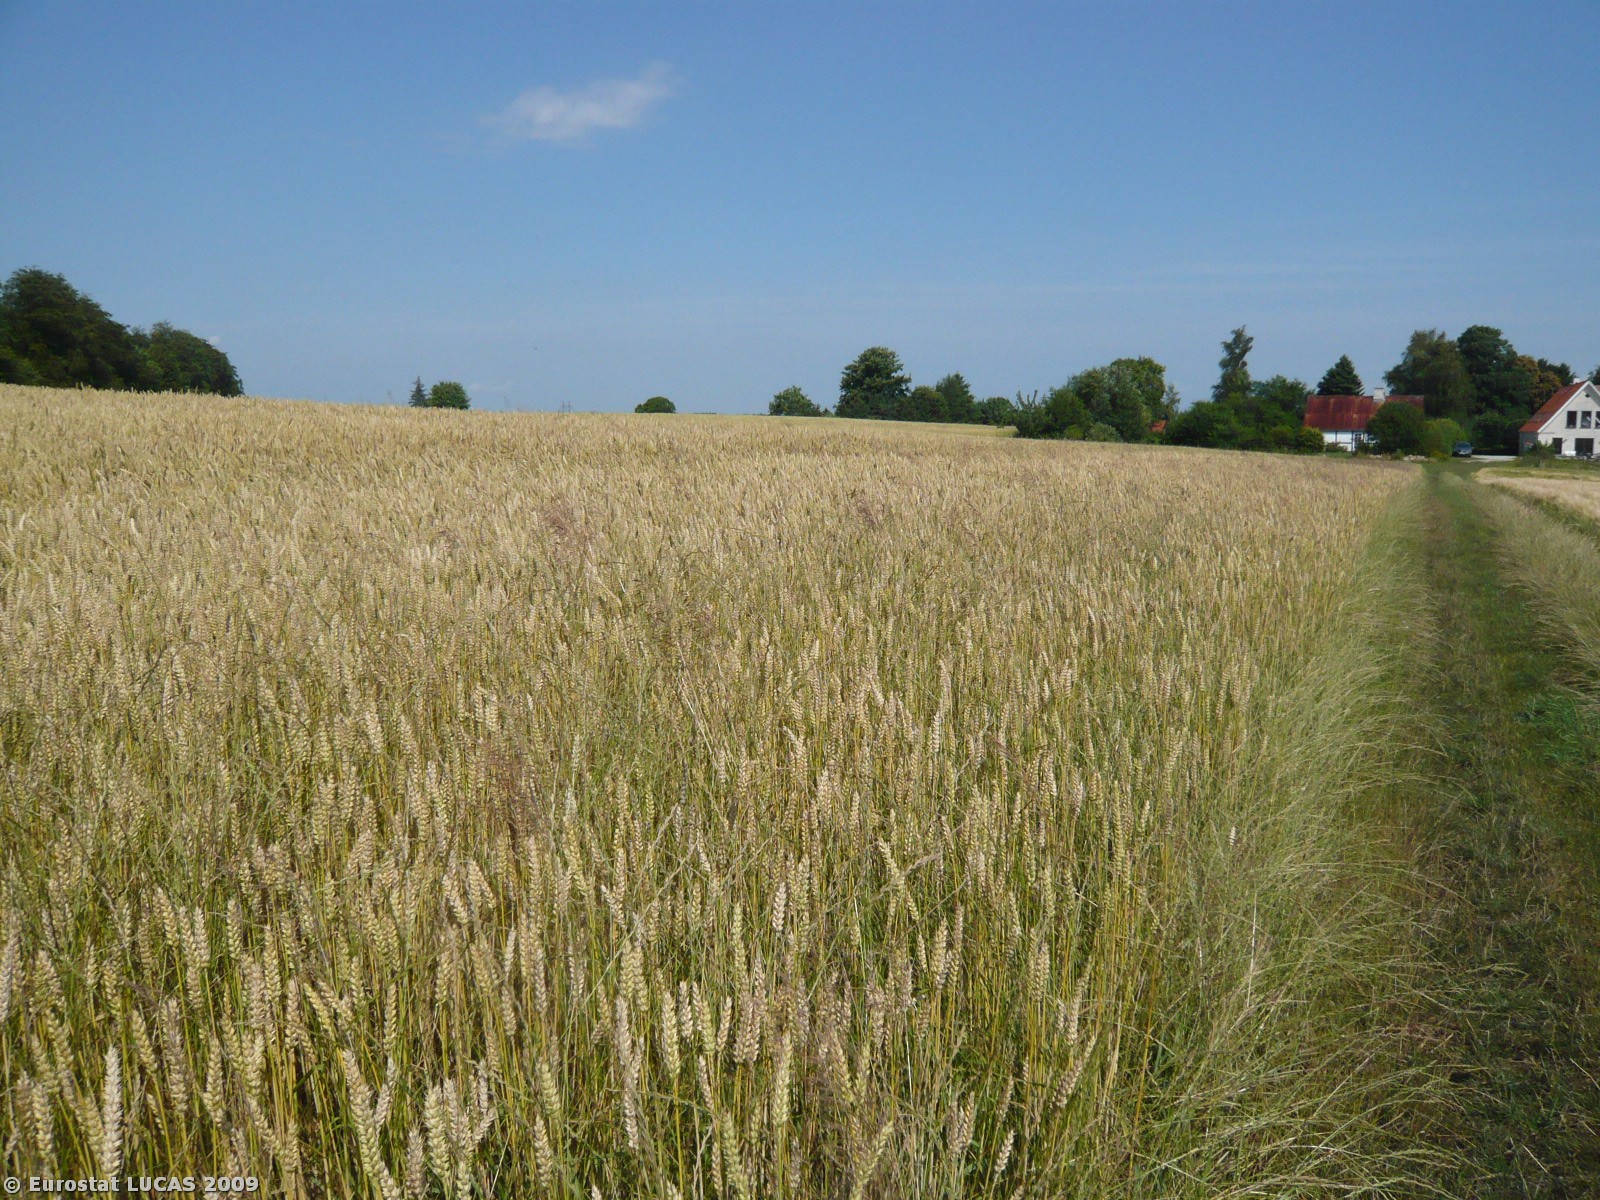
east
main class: Cropland
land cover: Common wheat
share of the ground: > 75 %
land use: Agriculture (excluding fallow land and kitchen gardens)
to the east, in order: Common wheat; Tracks; Barley
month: July
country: DK
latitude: 55.5806
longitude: 11.8861
